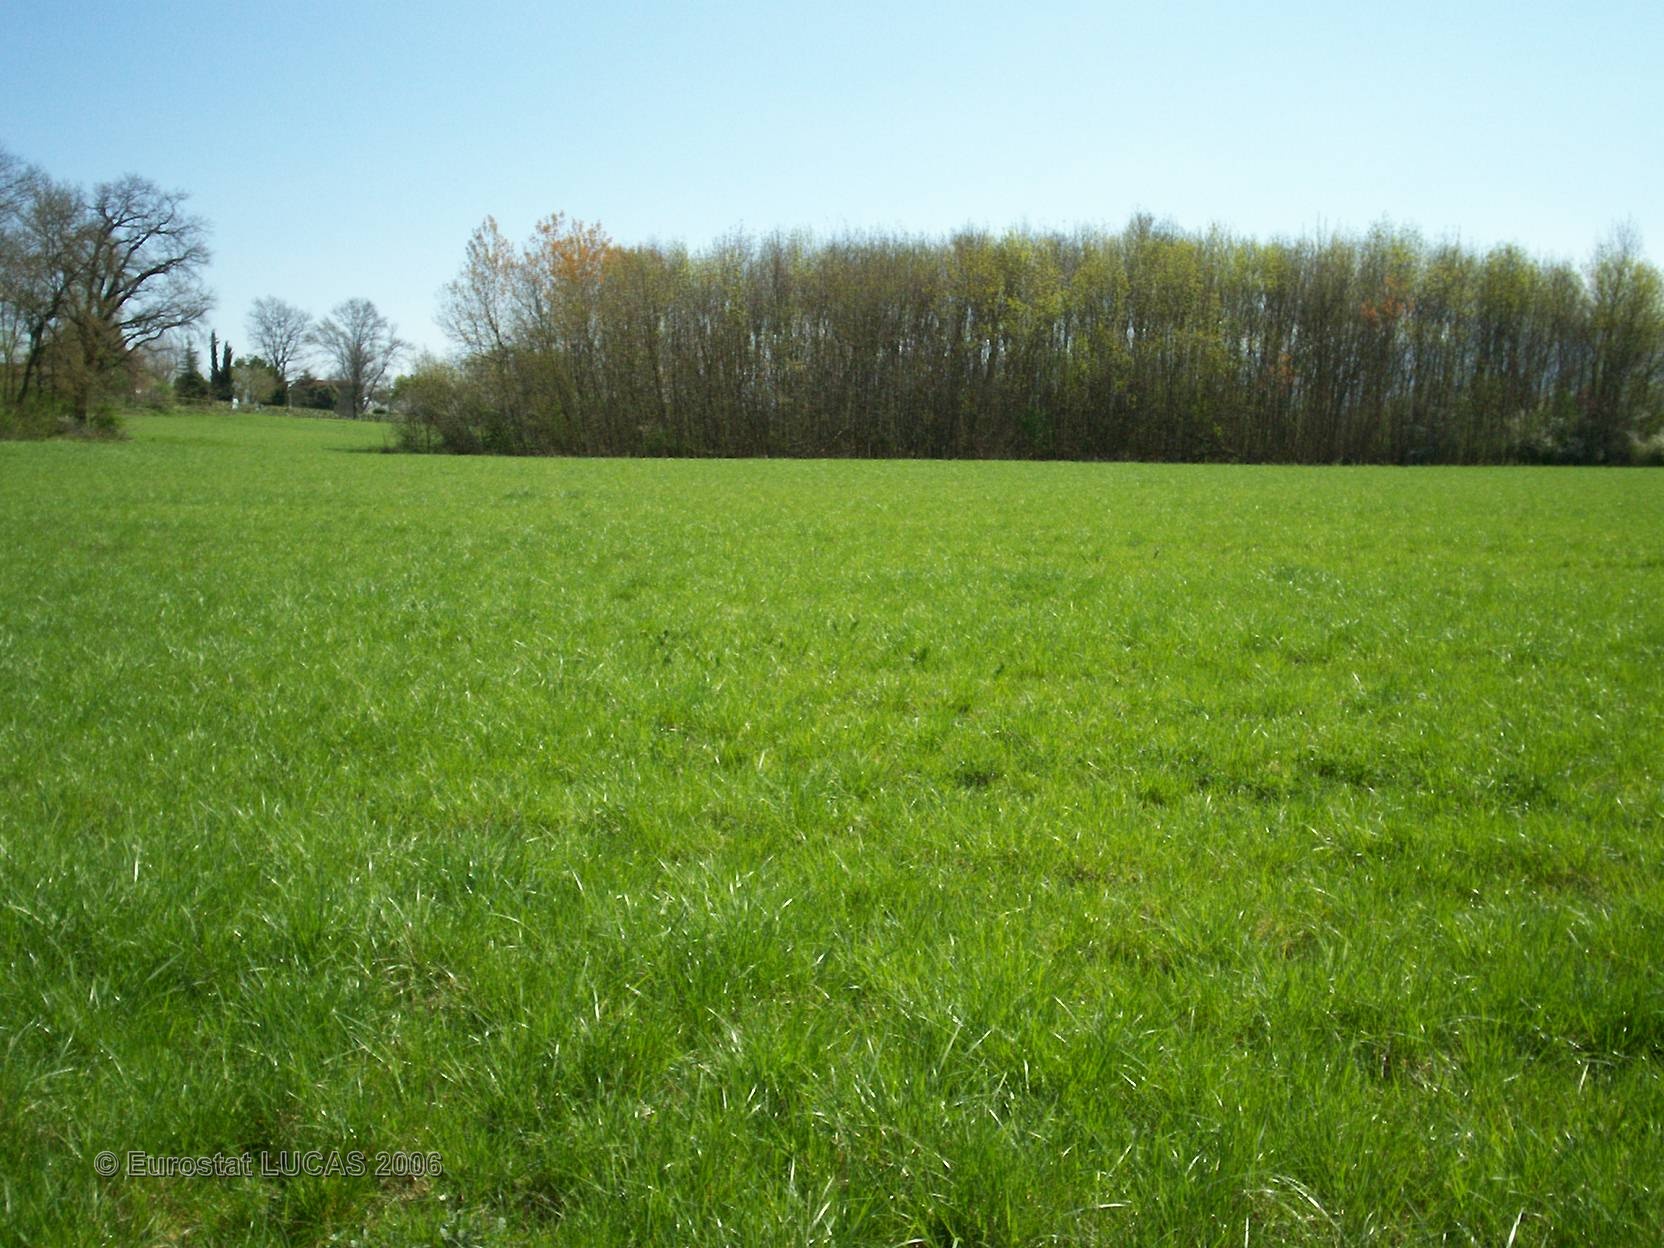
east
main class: Grassland
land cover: Grassland without tree/shrub cover
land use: Agriculture (excluding fallow land and kitchen gardens)
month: April
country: FR
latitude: 43.5198
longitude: 2.0506
